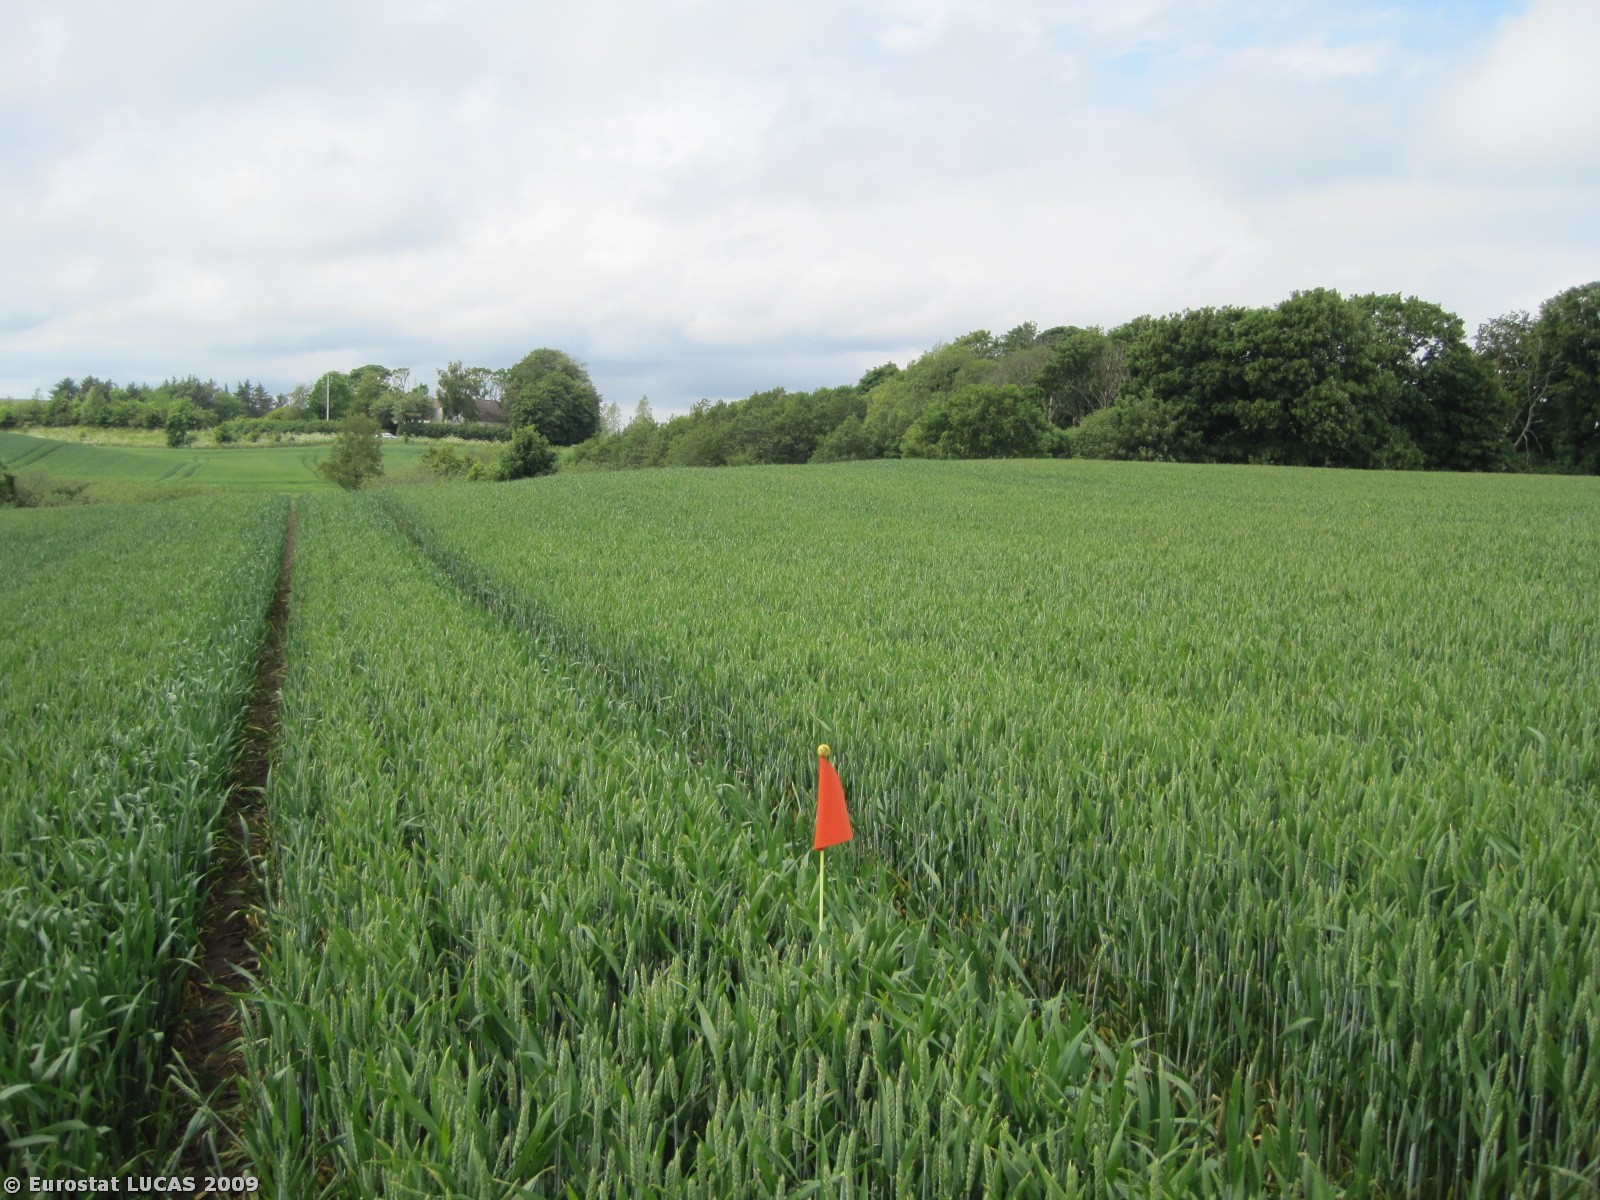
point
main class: Cropland
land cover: Common wheat
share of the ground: > 75 %
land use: Agriculture (excluding fallow land and kitchen gardens)
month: June
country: DK
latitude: 57.3561
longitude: 10.2489
